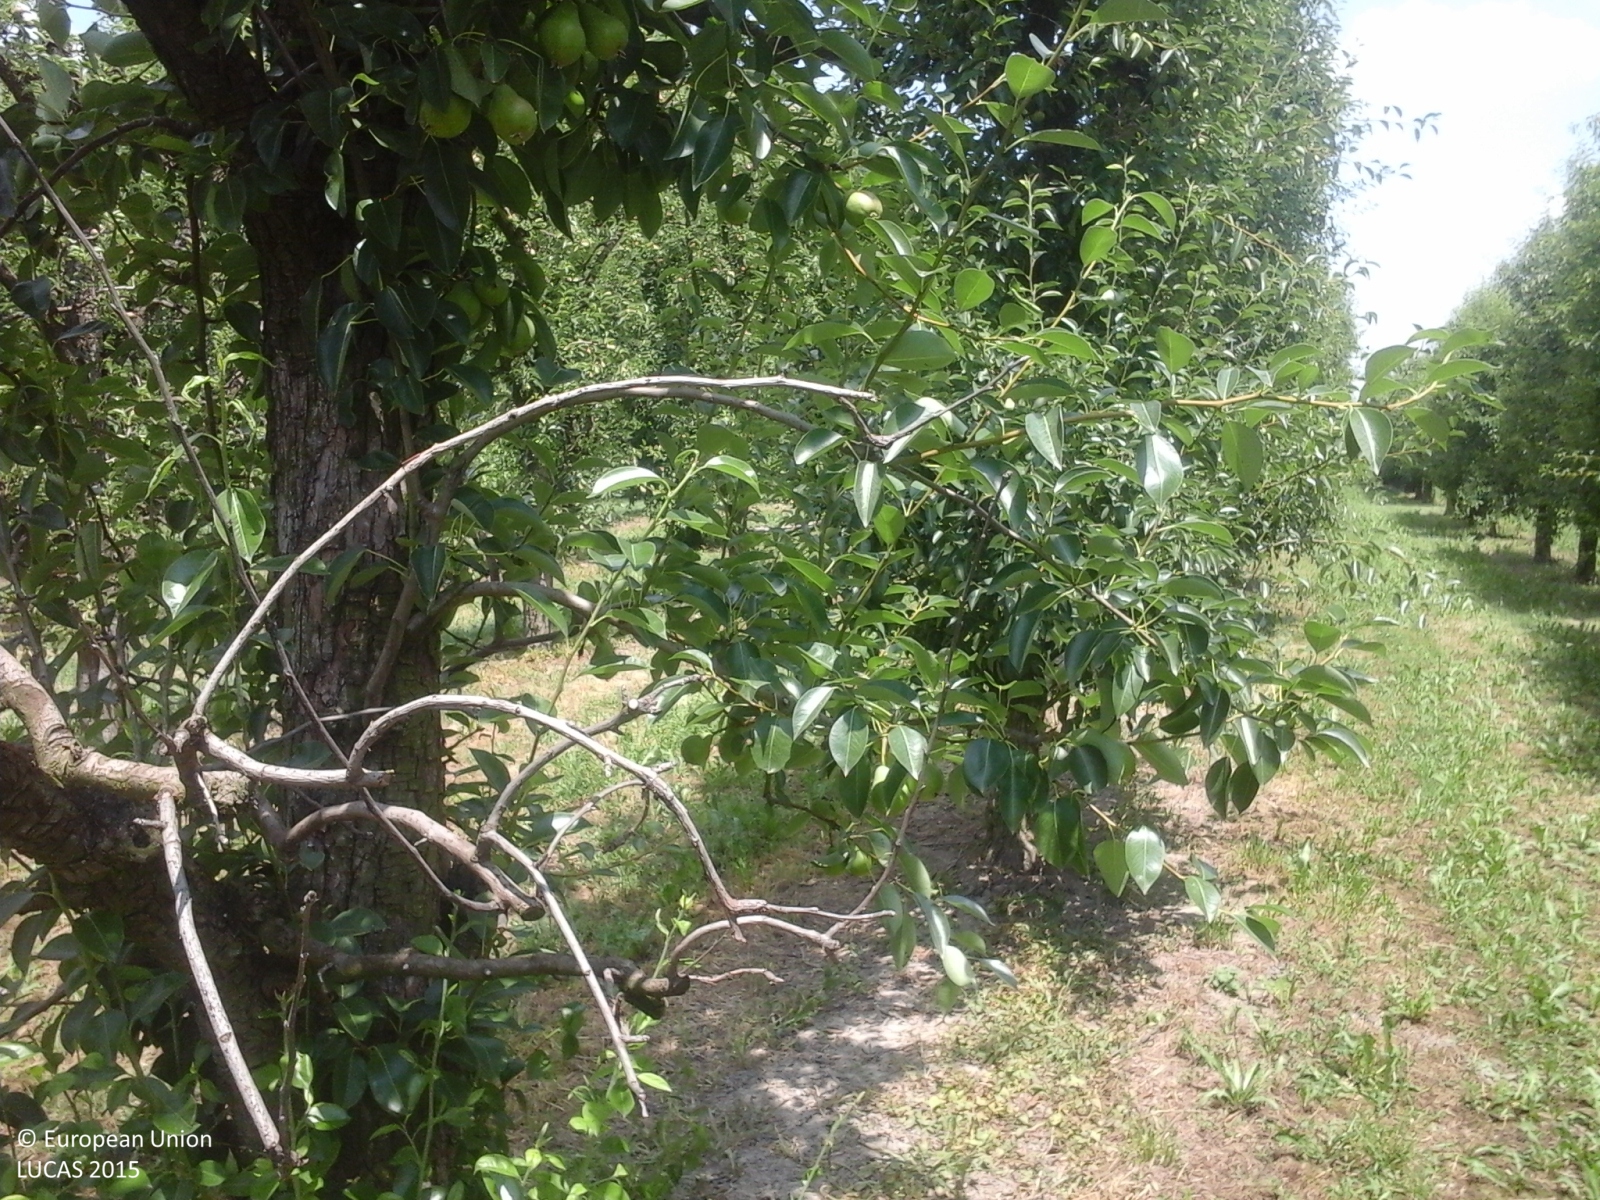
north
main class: Cropland
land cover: Pear fruit
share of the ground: > 75 %
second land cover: Grassland without tree/shrub cover
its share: > 75 %
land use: Agriculture (excluding fallow land and kitchen gardens)
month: June
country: IT
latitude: 44.7969
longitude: 10.9714
